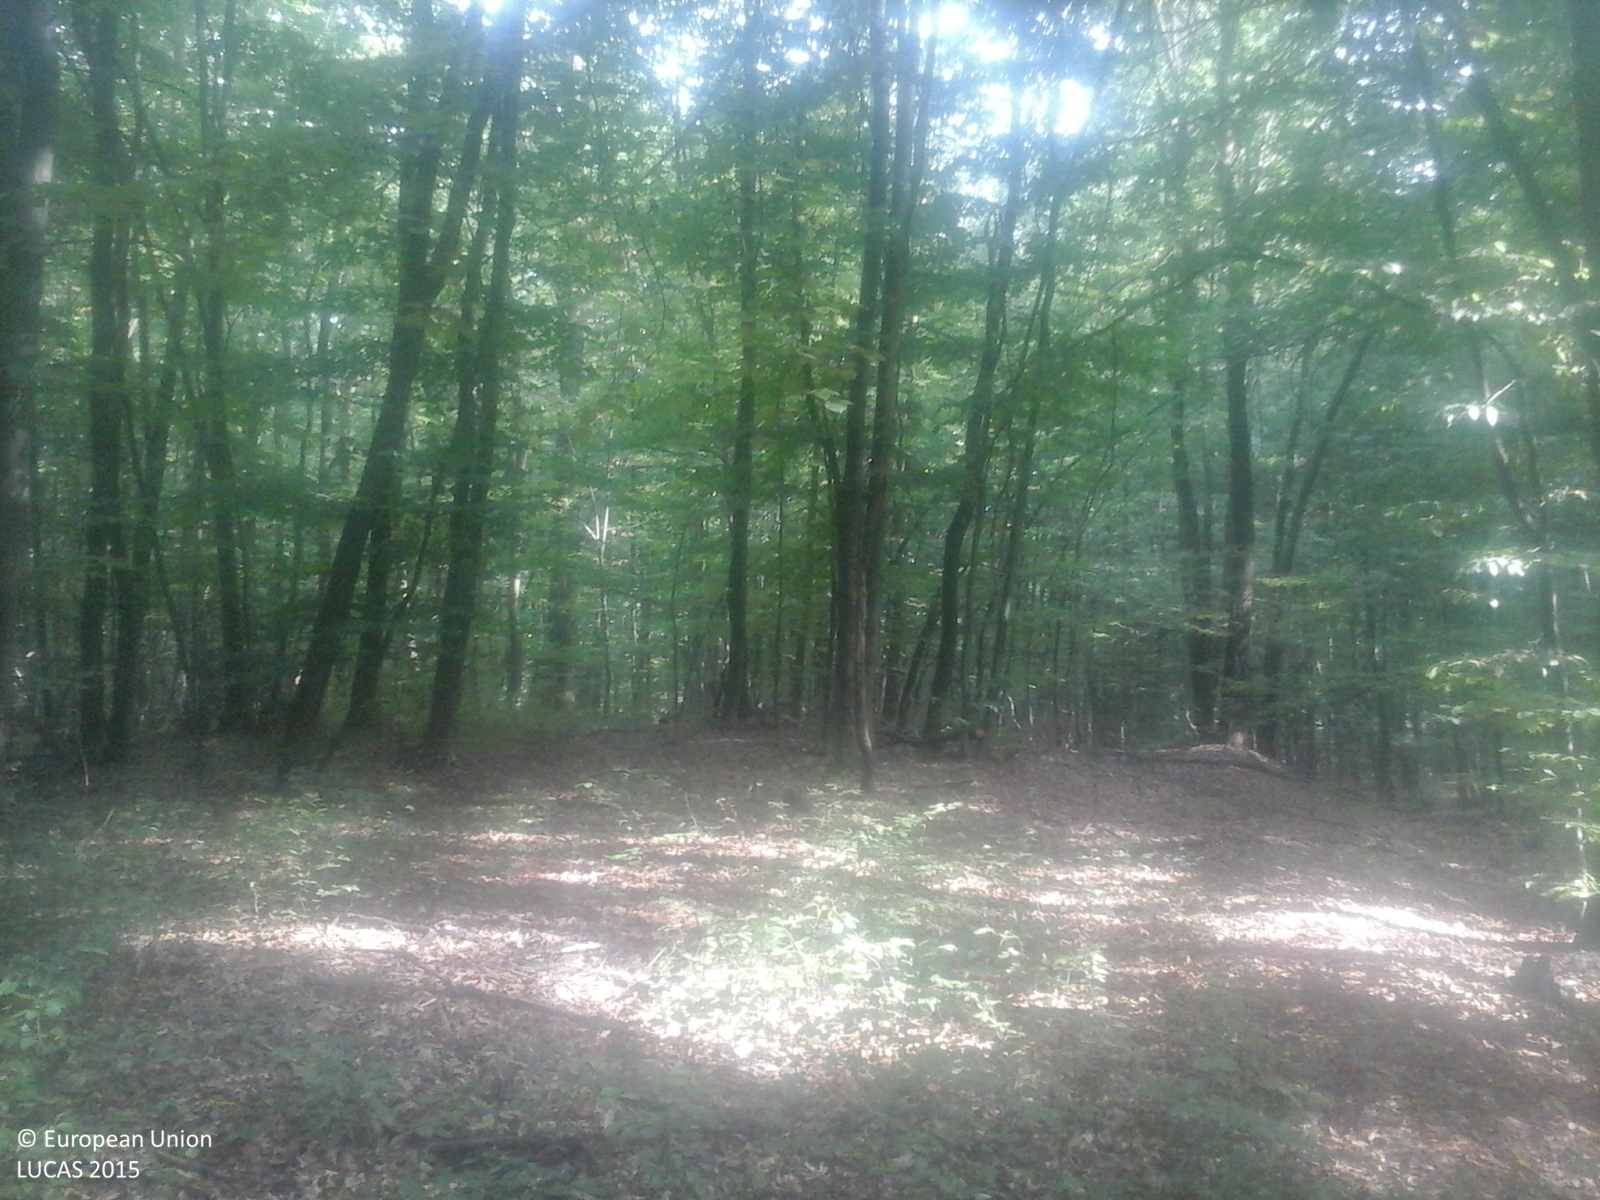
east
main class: Woodland
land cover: Broadleaved woodland
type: beech forest
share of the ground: > 75 %
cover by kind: broadleaved forest trees 100 %
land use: Forestry
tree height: > 5 m
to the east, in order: Broadleaved woodland
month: September
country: RO
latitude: 47.1452
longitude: 23.1066
